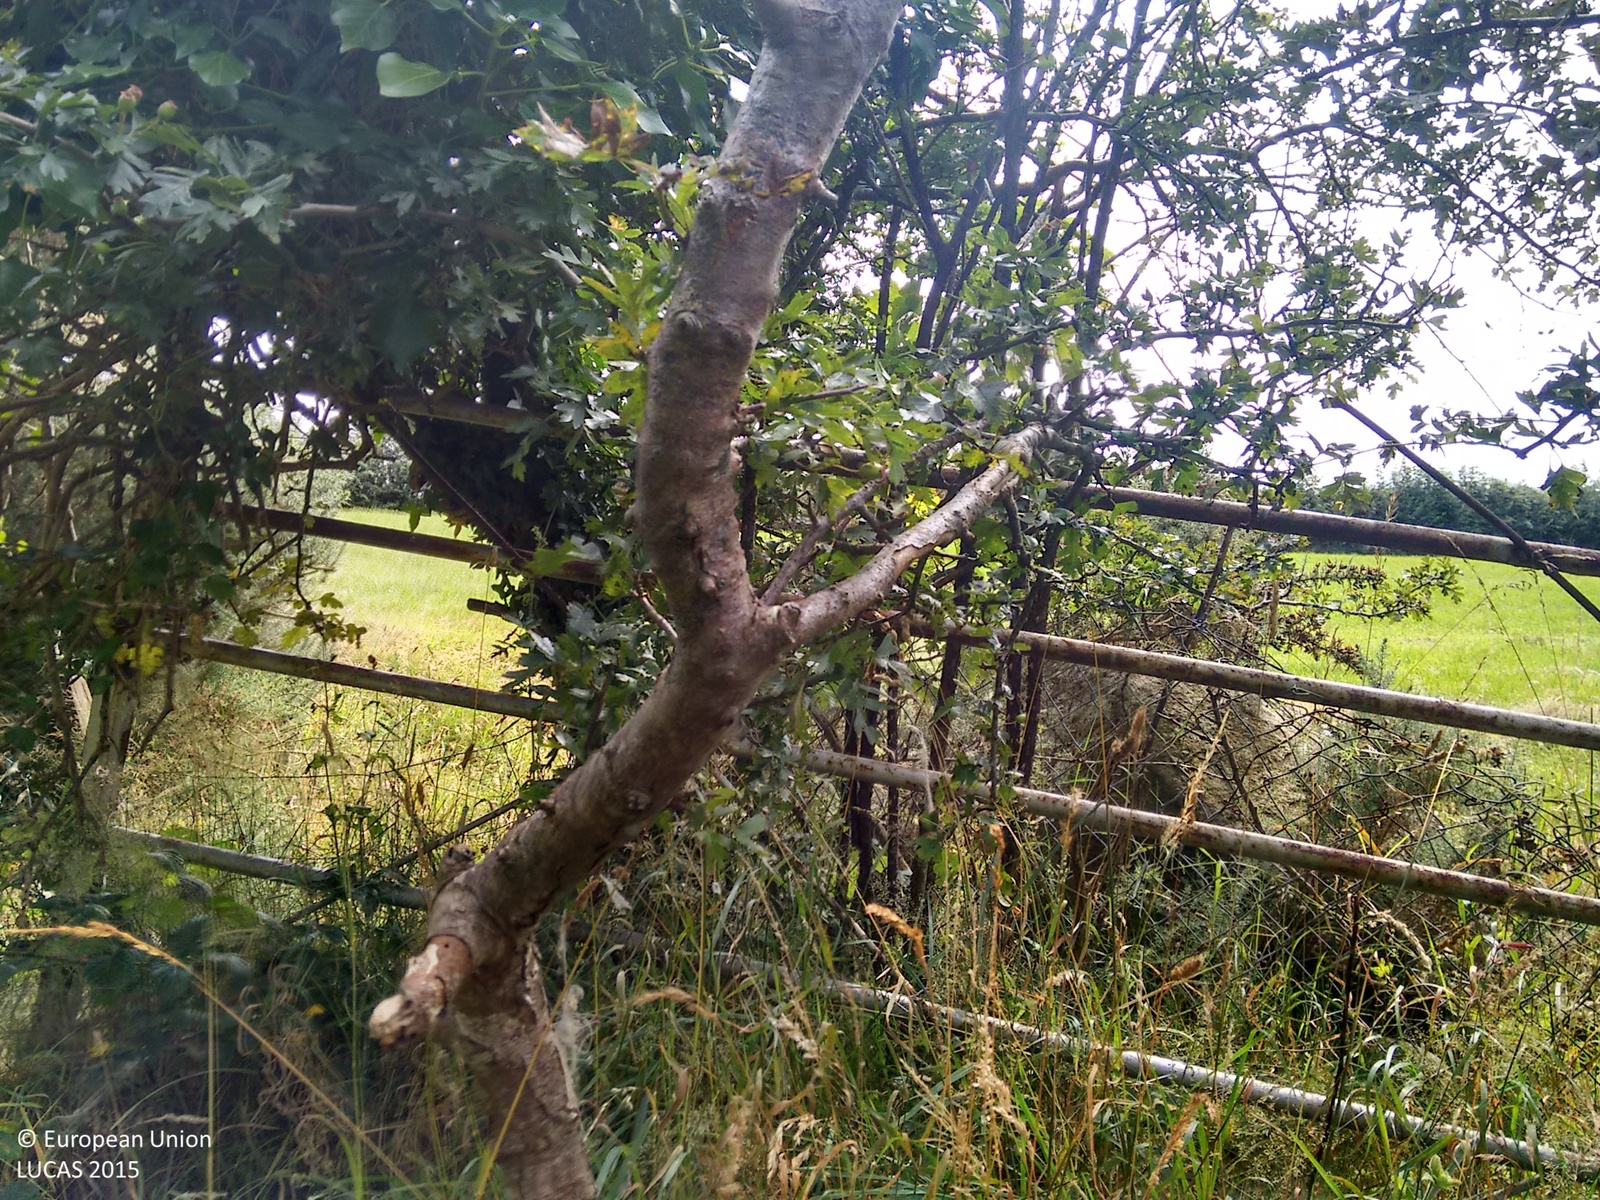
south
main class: Grassland
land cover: Grassland without tree/shrub cover
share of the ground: > 75 %
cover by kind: herbaceous plants 100 %
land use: Agriculture (excluding fallow land and kitchen gardens)
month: August
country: GB
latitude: 52.9440
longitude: -4.3431
